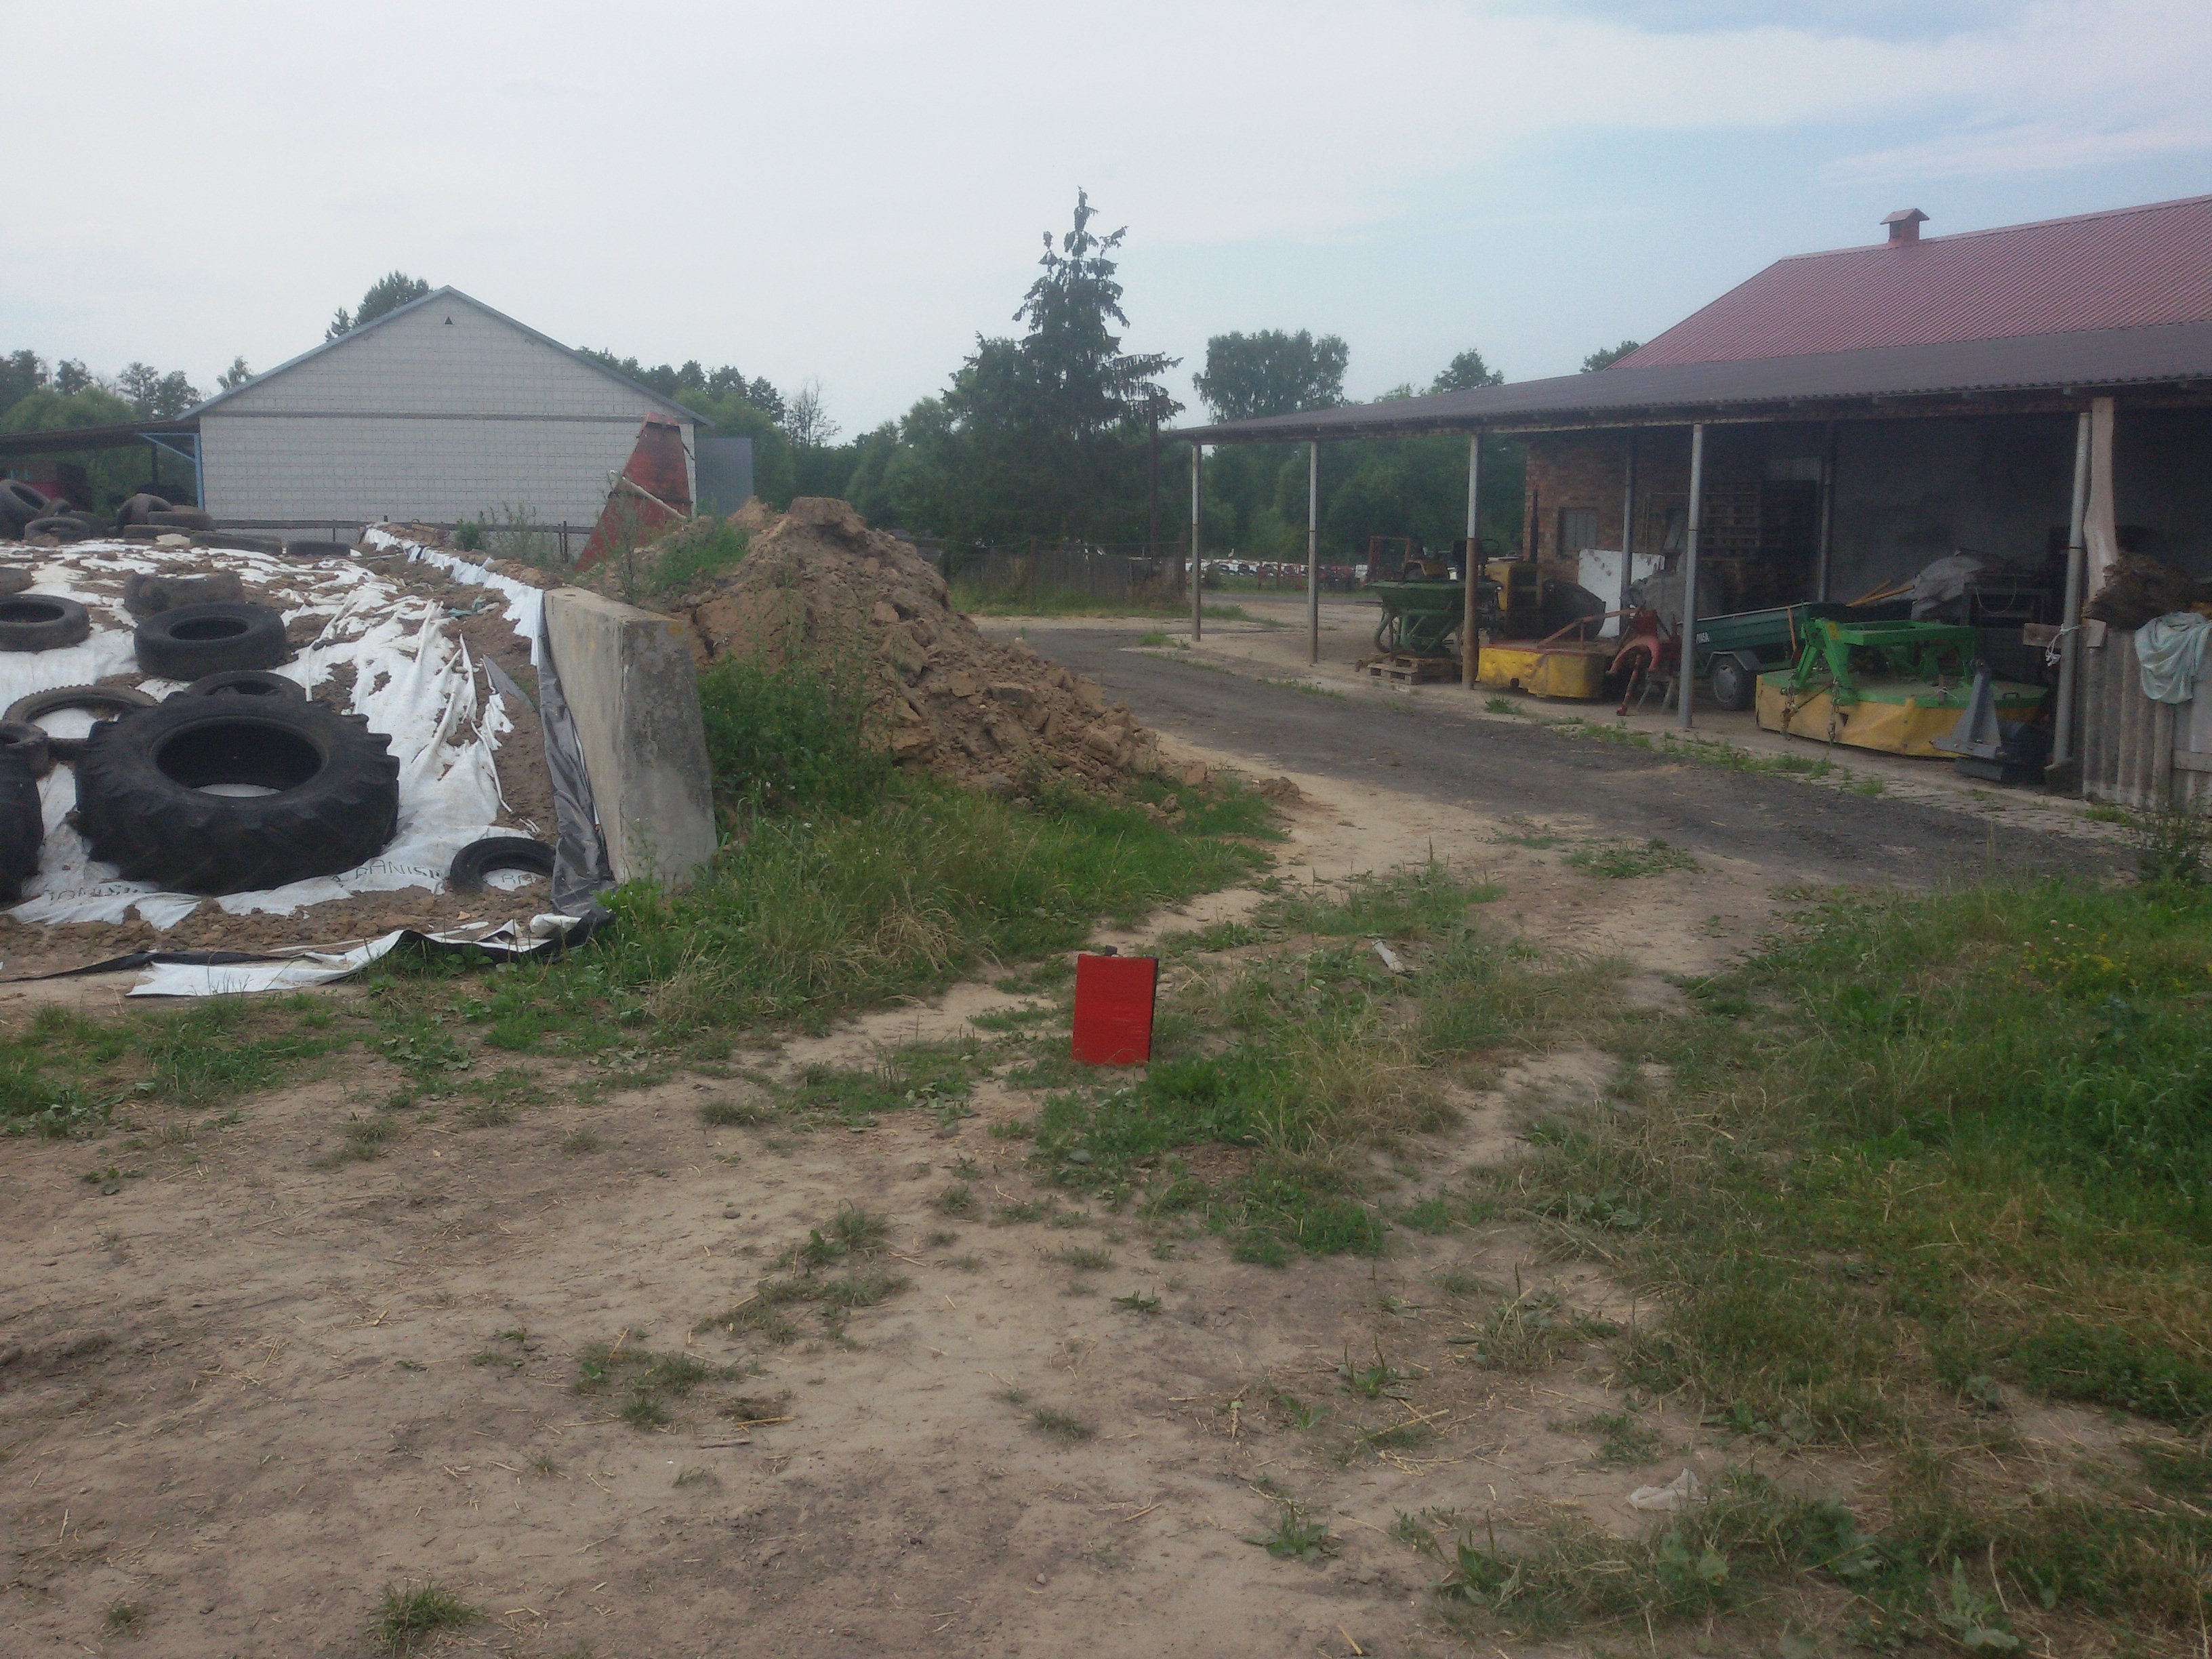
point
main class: Grassland
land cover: Spontaneously vegetated surfaces
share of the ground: 50 - 75 %
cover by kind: herbaceous plants 55 %, unconsolidated bare surface 45 %
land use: Agriculture (excluding fallow land and kitchen gardens)
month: May
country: PL
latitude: 52.8349
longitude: 22.2187
